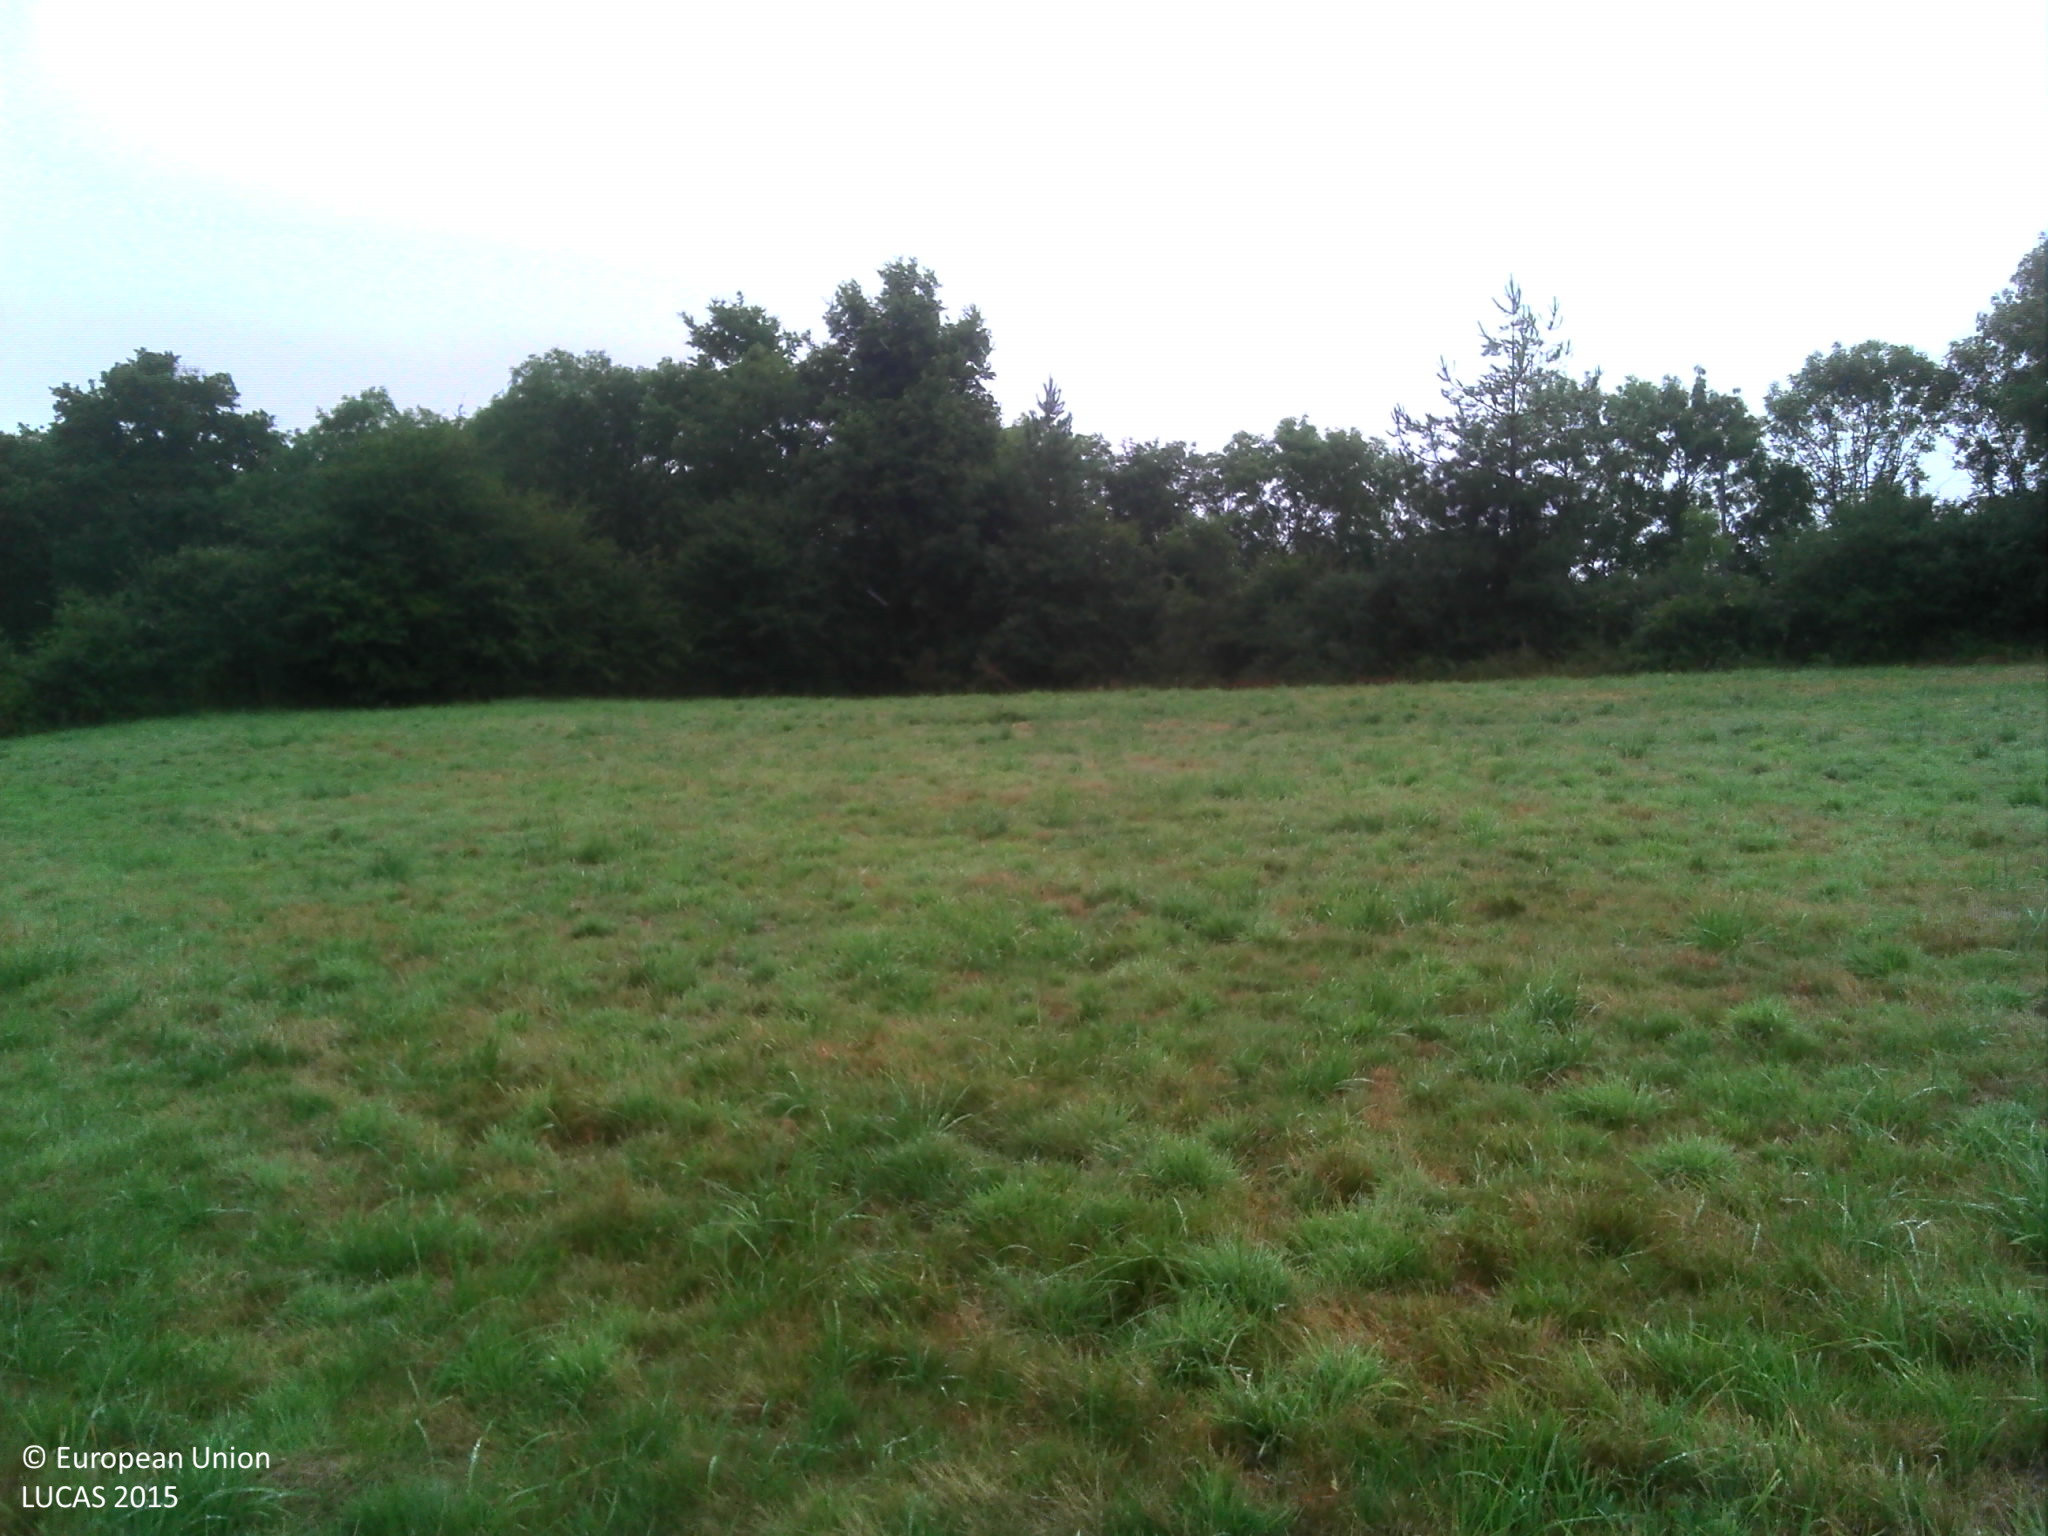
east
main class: Grassland
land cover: Grassland without tree/shrub cover
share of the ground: > 75 %
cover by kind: herbaceous plants 100 %
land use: Agriculture (excluding fallow land and kitchen gardens)
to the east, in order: Grassland without tree/shrub cover; Fences; Managed hedges; Ditches and canals; Grass margins; Paved roads, cycling and walking lanes; Grass margins; Ditches and canals; Managed hedges; Grassland without tree/shrub cover; Inland fresh water bodies; Grassland without tree/shrub cover; Spontaneously vegetated surfaces; Managed hedges; Maize
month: July
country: FR
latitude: 46.5590
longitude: -1.5570
